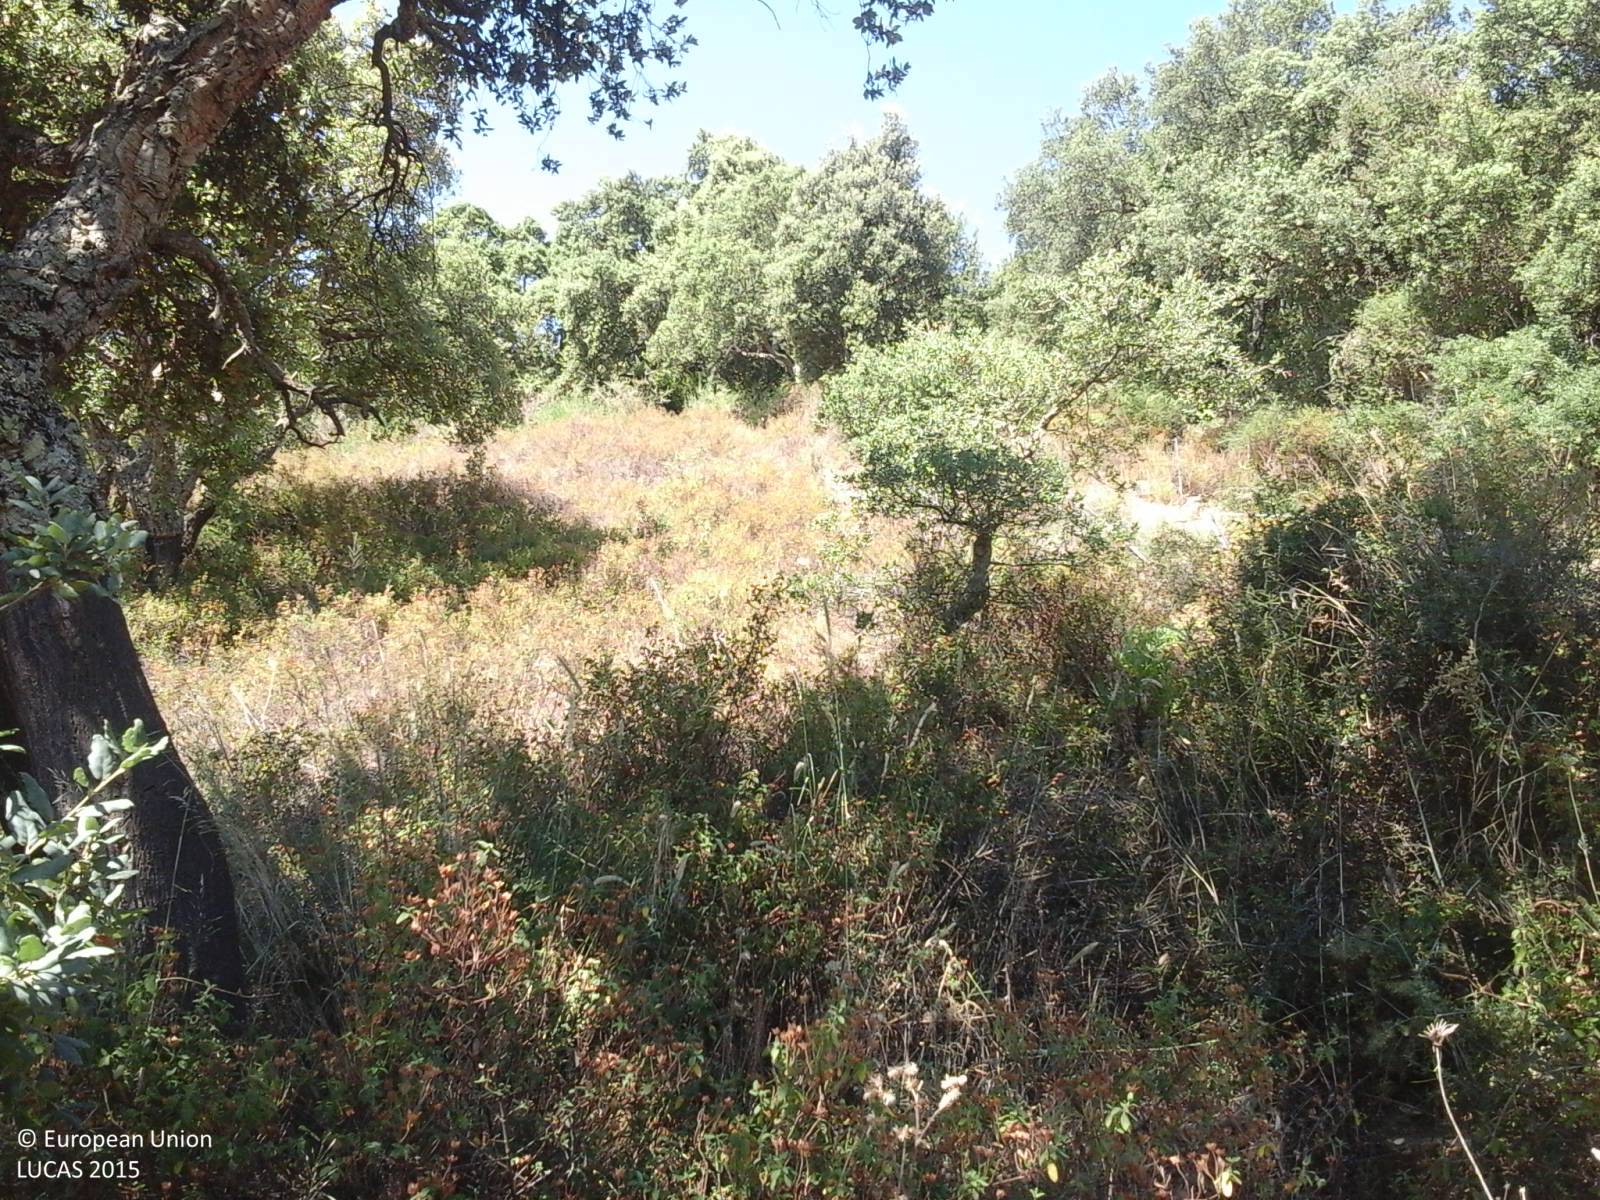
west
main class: Woodland
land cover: Broadleaved woodland
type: broadleaved evergreen forest
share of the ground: > 75 %
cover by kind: broadleaved forest trees 80 %, herbaceous plants 15 %, shrubs 5 %
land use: Semi-natural and natural areas not in use
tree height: > 5 m
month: July
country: IT
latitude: 39.5326
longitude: 8.5773
